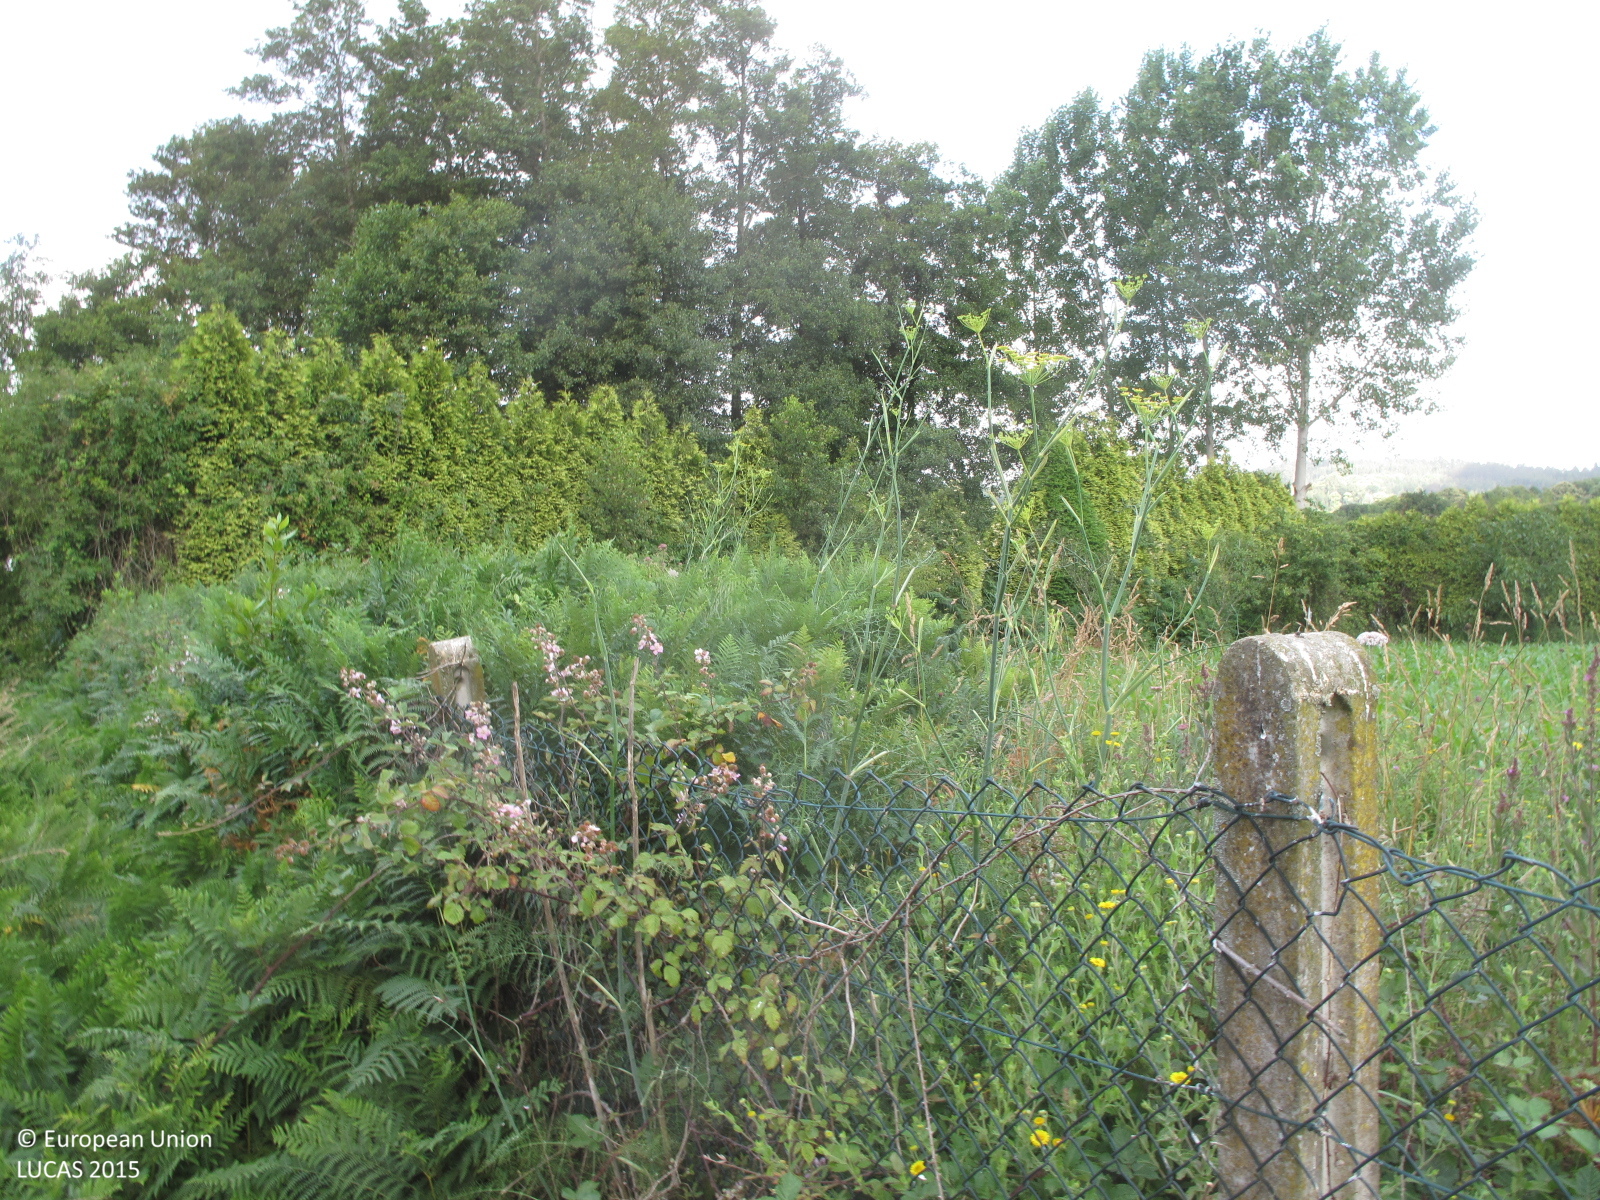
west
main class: Cropland
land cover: Maize
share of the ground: 25 - 50 %
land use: Agriculture (excluding fallow land and kitchen gardens)
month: July
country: ES
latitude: 43.3563
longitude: -8.2770
